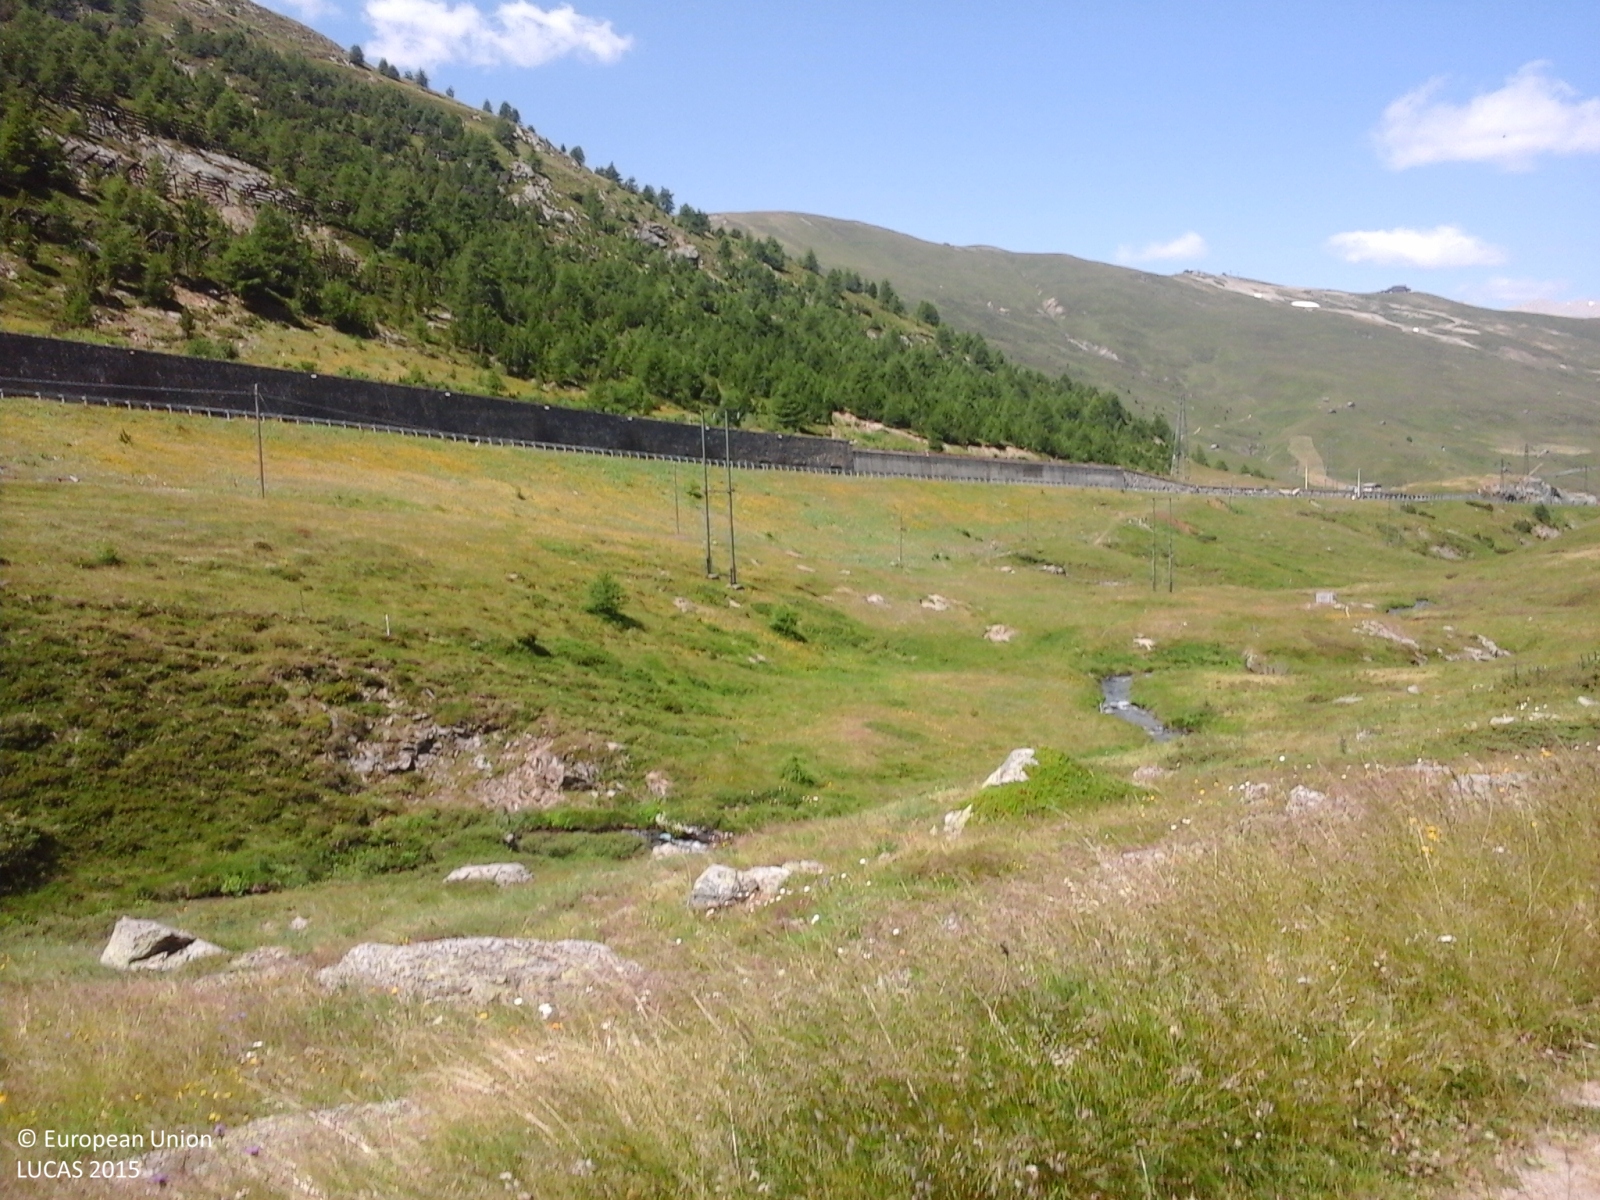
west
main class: Grassland
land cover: Grassland without tree/shrub cover
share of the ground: > 75 %
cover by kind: herbaceous plants 70 %, consolidated bare surface 30 %
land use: Agriculture (excluding fallow land and kitchen gardens)
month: July
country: IT
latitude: 46.5131
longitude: 10.1952
